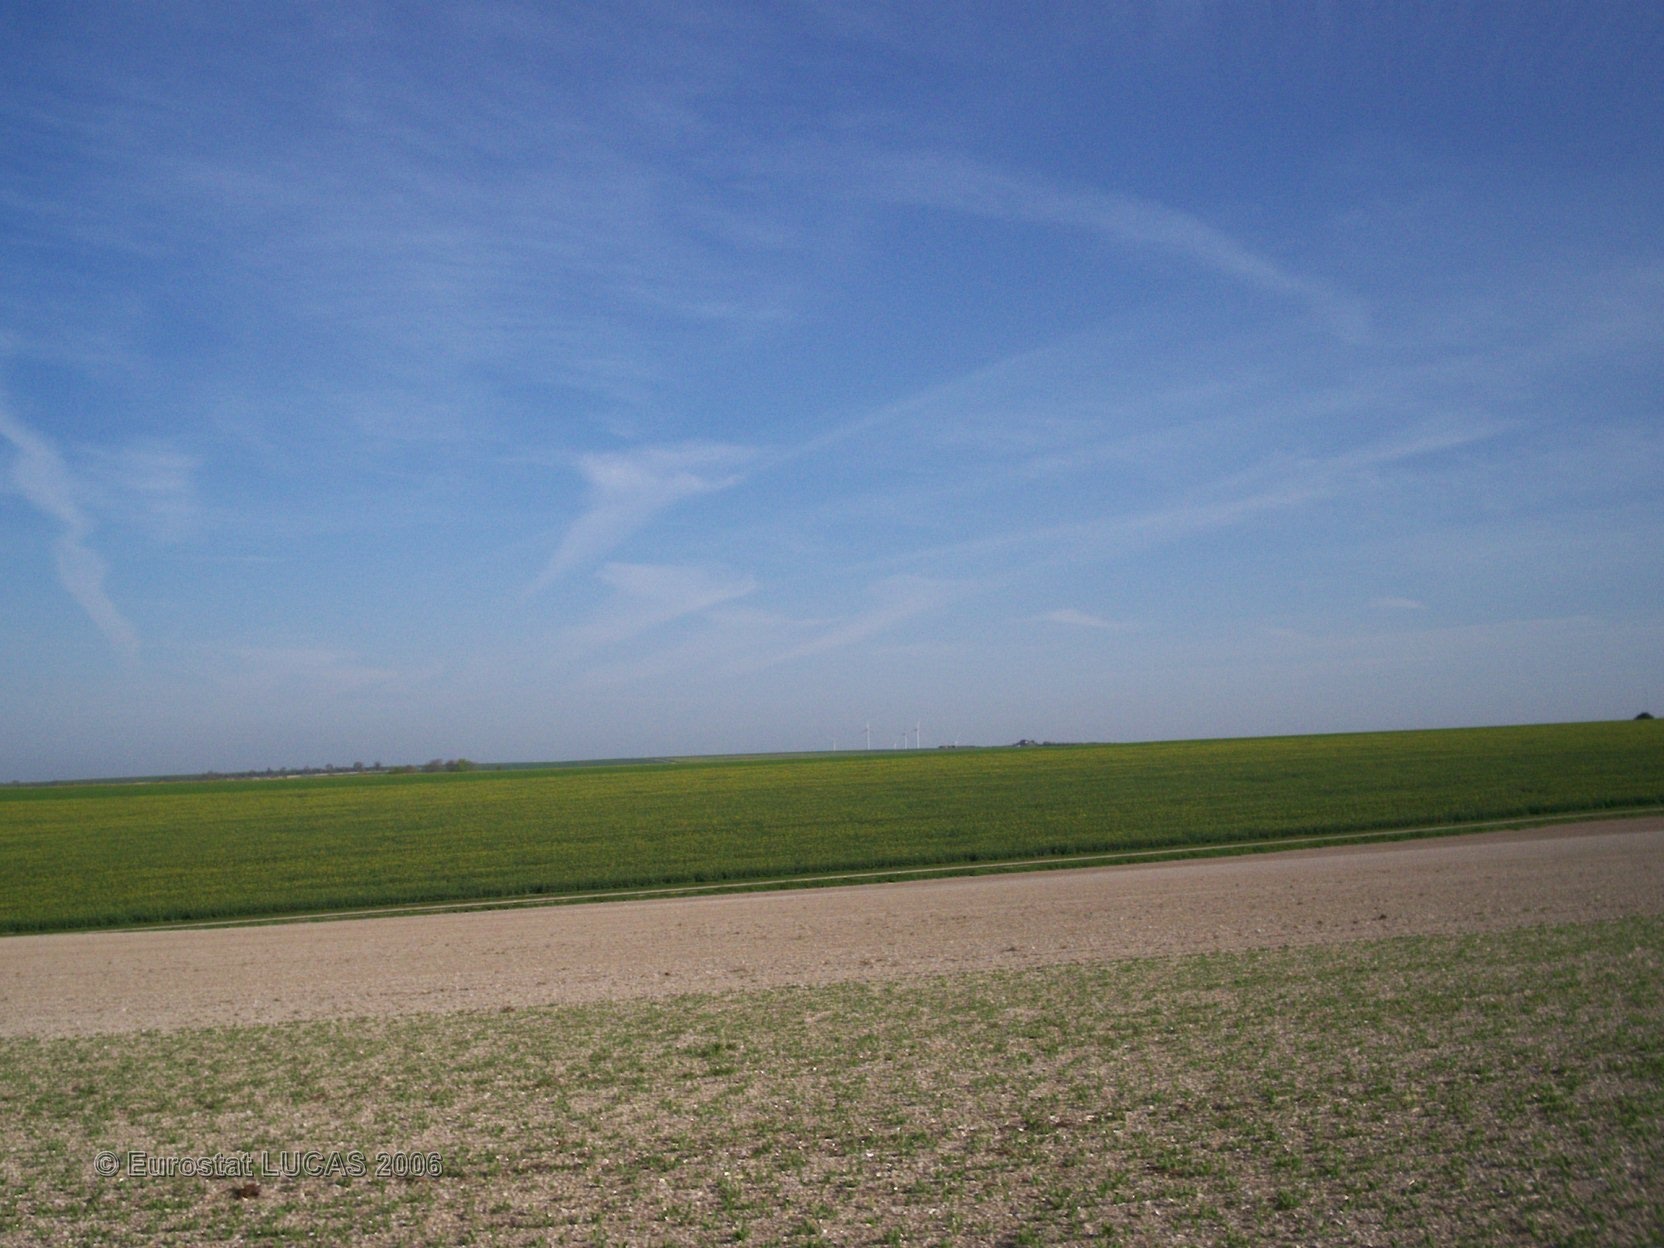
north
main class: Cropland
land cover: Dry pulses
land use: Agriculture (excluding fallow land and kitchen gardens)
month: May
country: FR
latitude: 48.7848
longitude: 4.4028
